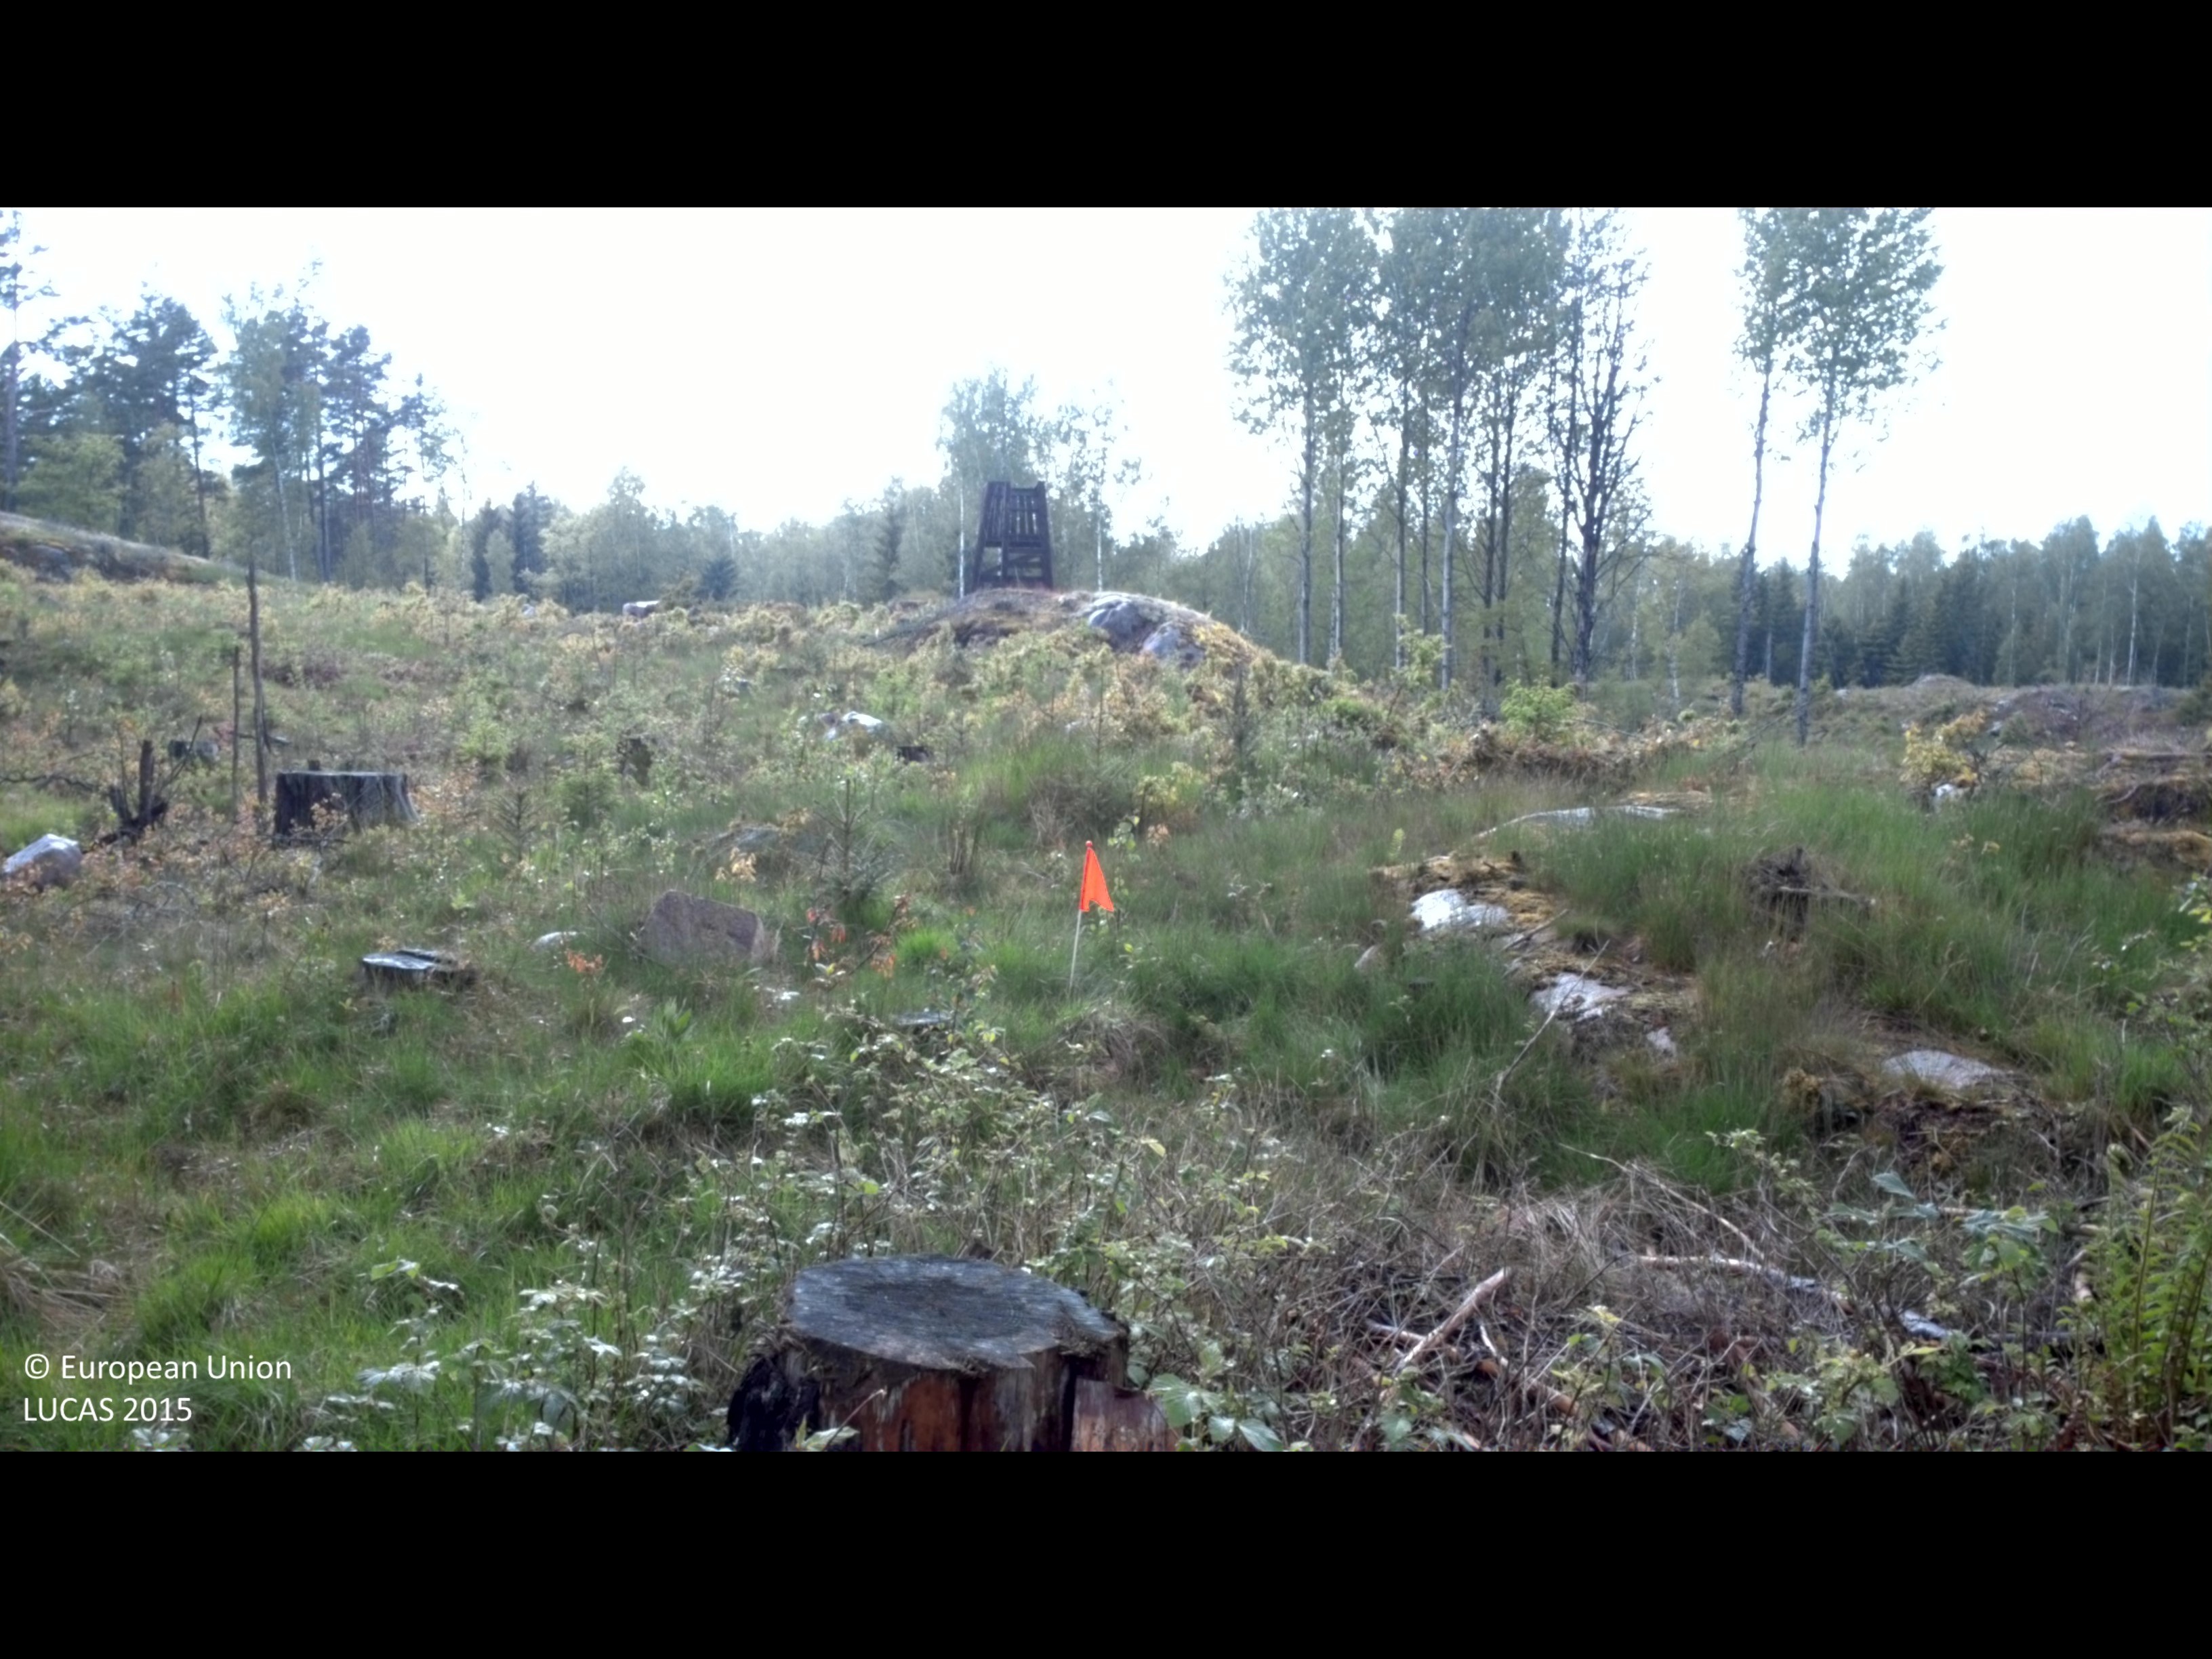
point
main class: Woodland
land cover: Broadleaved woodland
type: hemiboreal forest and nemoral coniferous forest and mixed broadleaved-coniferous forest
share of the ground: 25 - 50 %
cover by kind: broadleaved forest trees 40 %, shrubs 25 %, herbaceous plants 20 %, coniferous forest trees 10 %, lichens and mosses 5 %
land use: Forestry
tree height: > 5 m
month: May
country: SE
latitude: 57.4462
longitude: 16.5479
